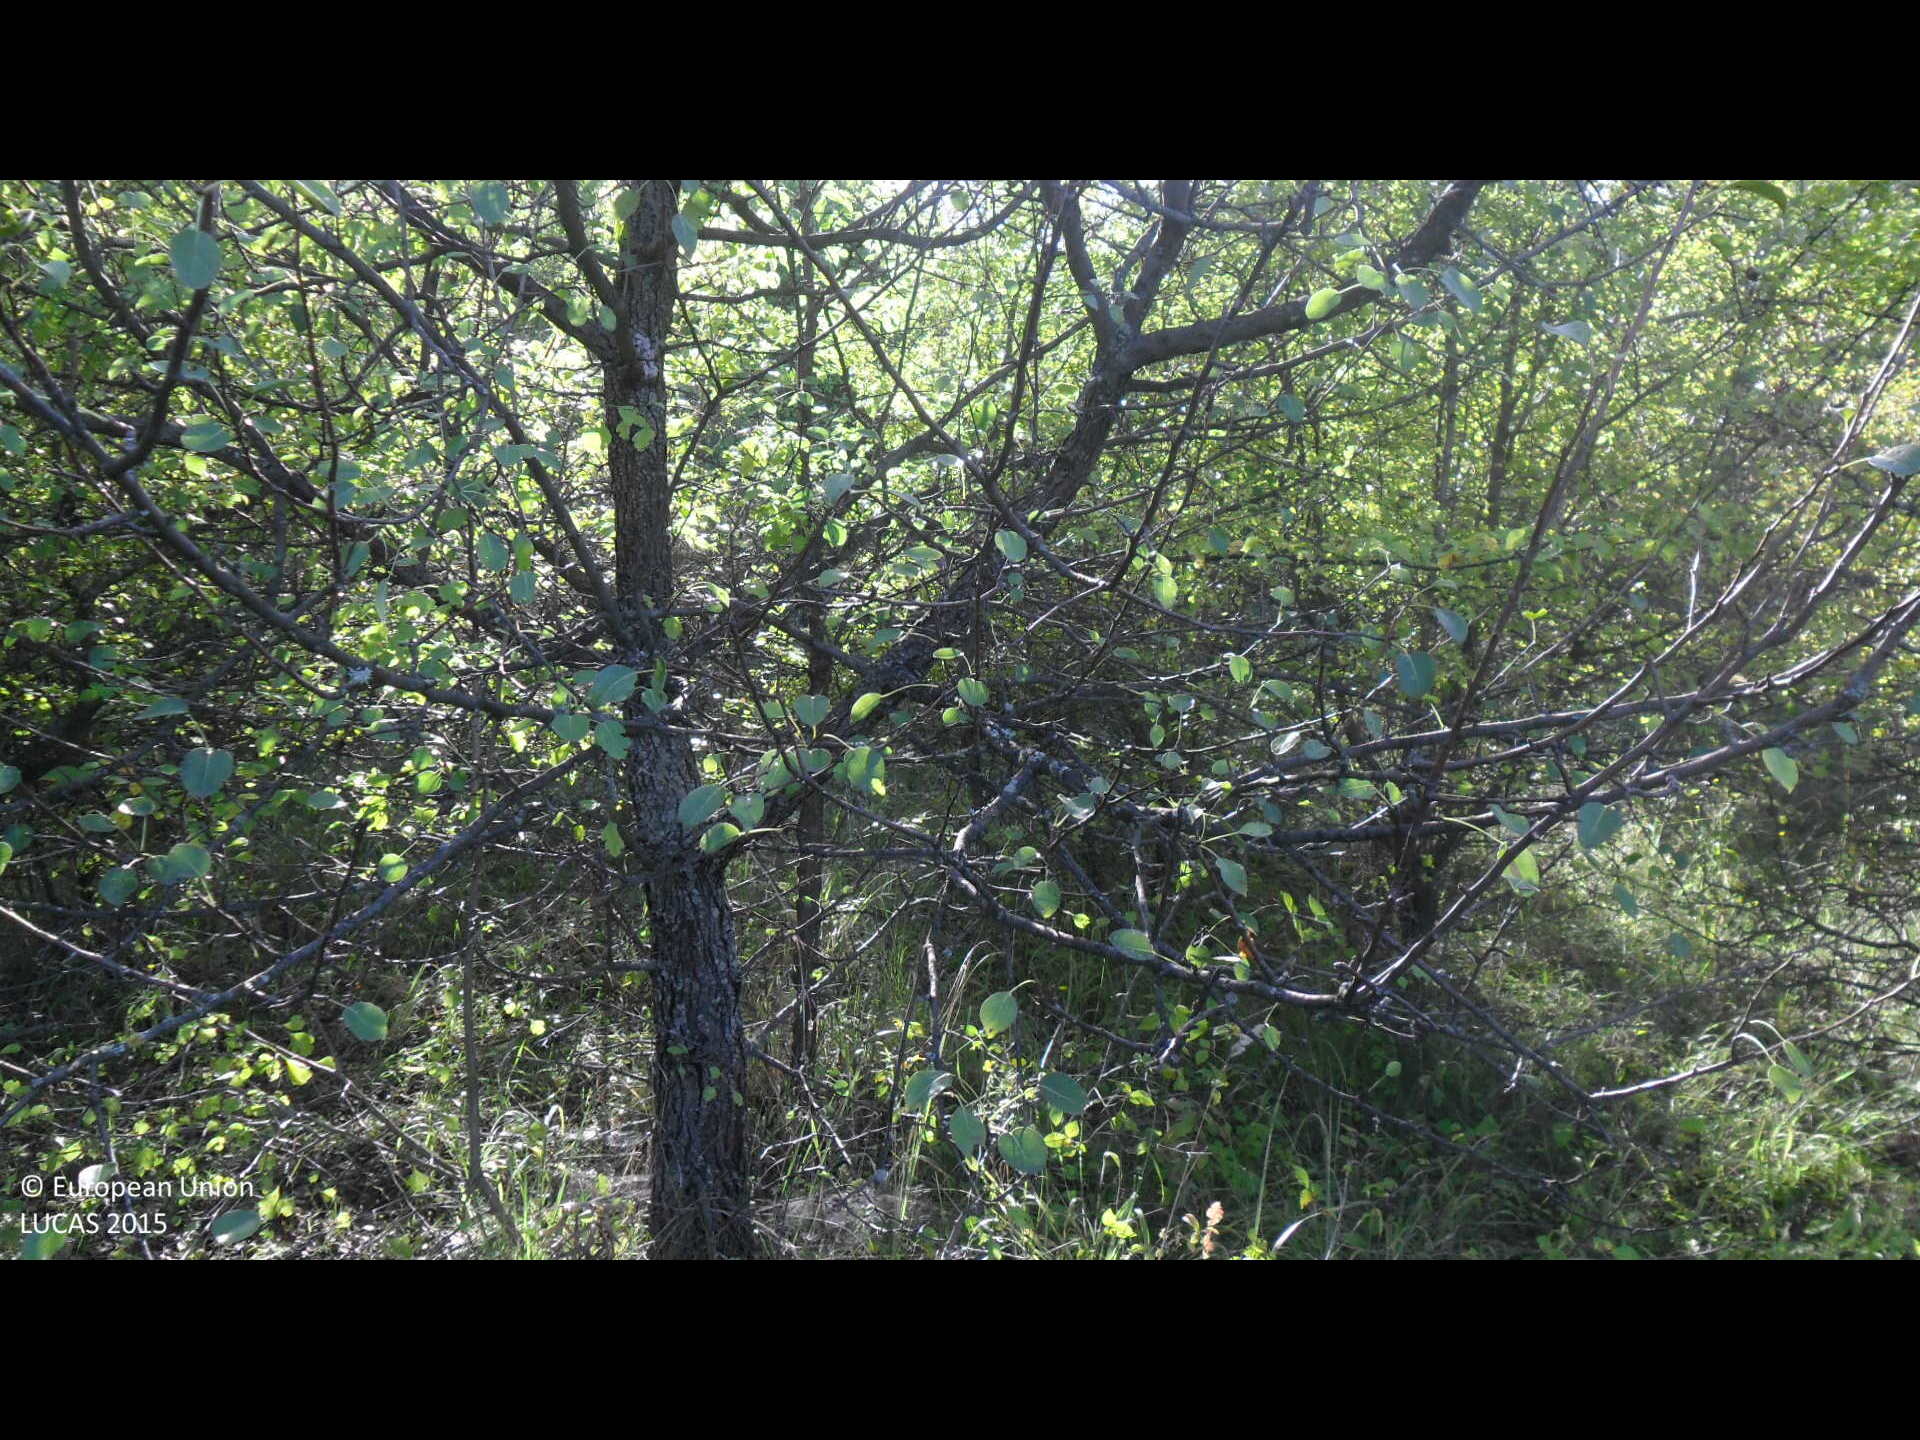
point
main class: Shrubland
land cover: Shrubland with sparse tree cover
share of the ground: > 75 %
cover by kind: shrubs 95 %, broadleaved forest trees 5 %
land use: Semi-natural and natural areas not in use
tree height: > 5 m
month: September
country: BG
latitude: 43.2580
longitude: 26.4975
